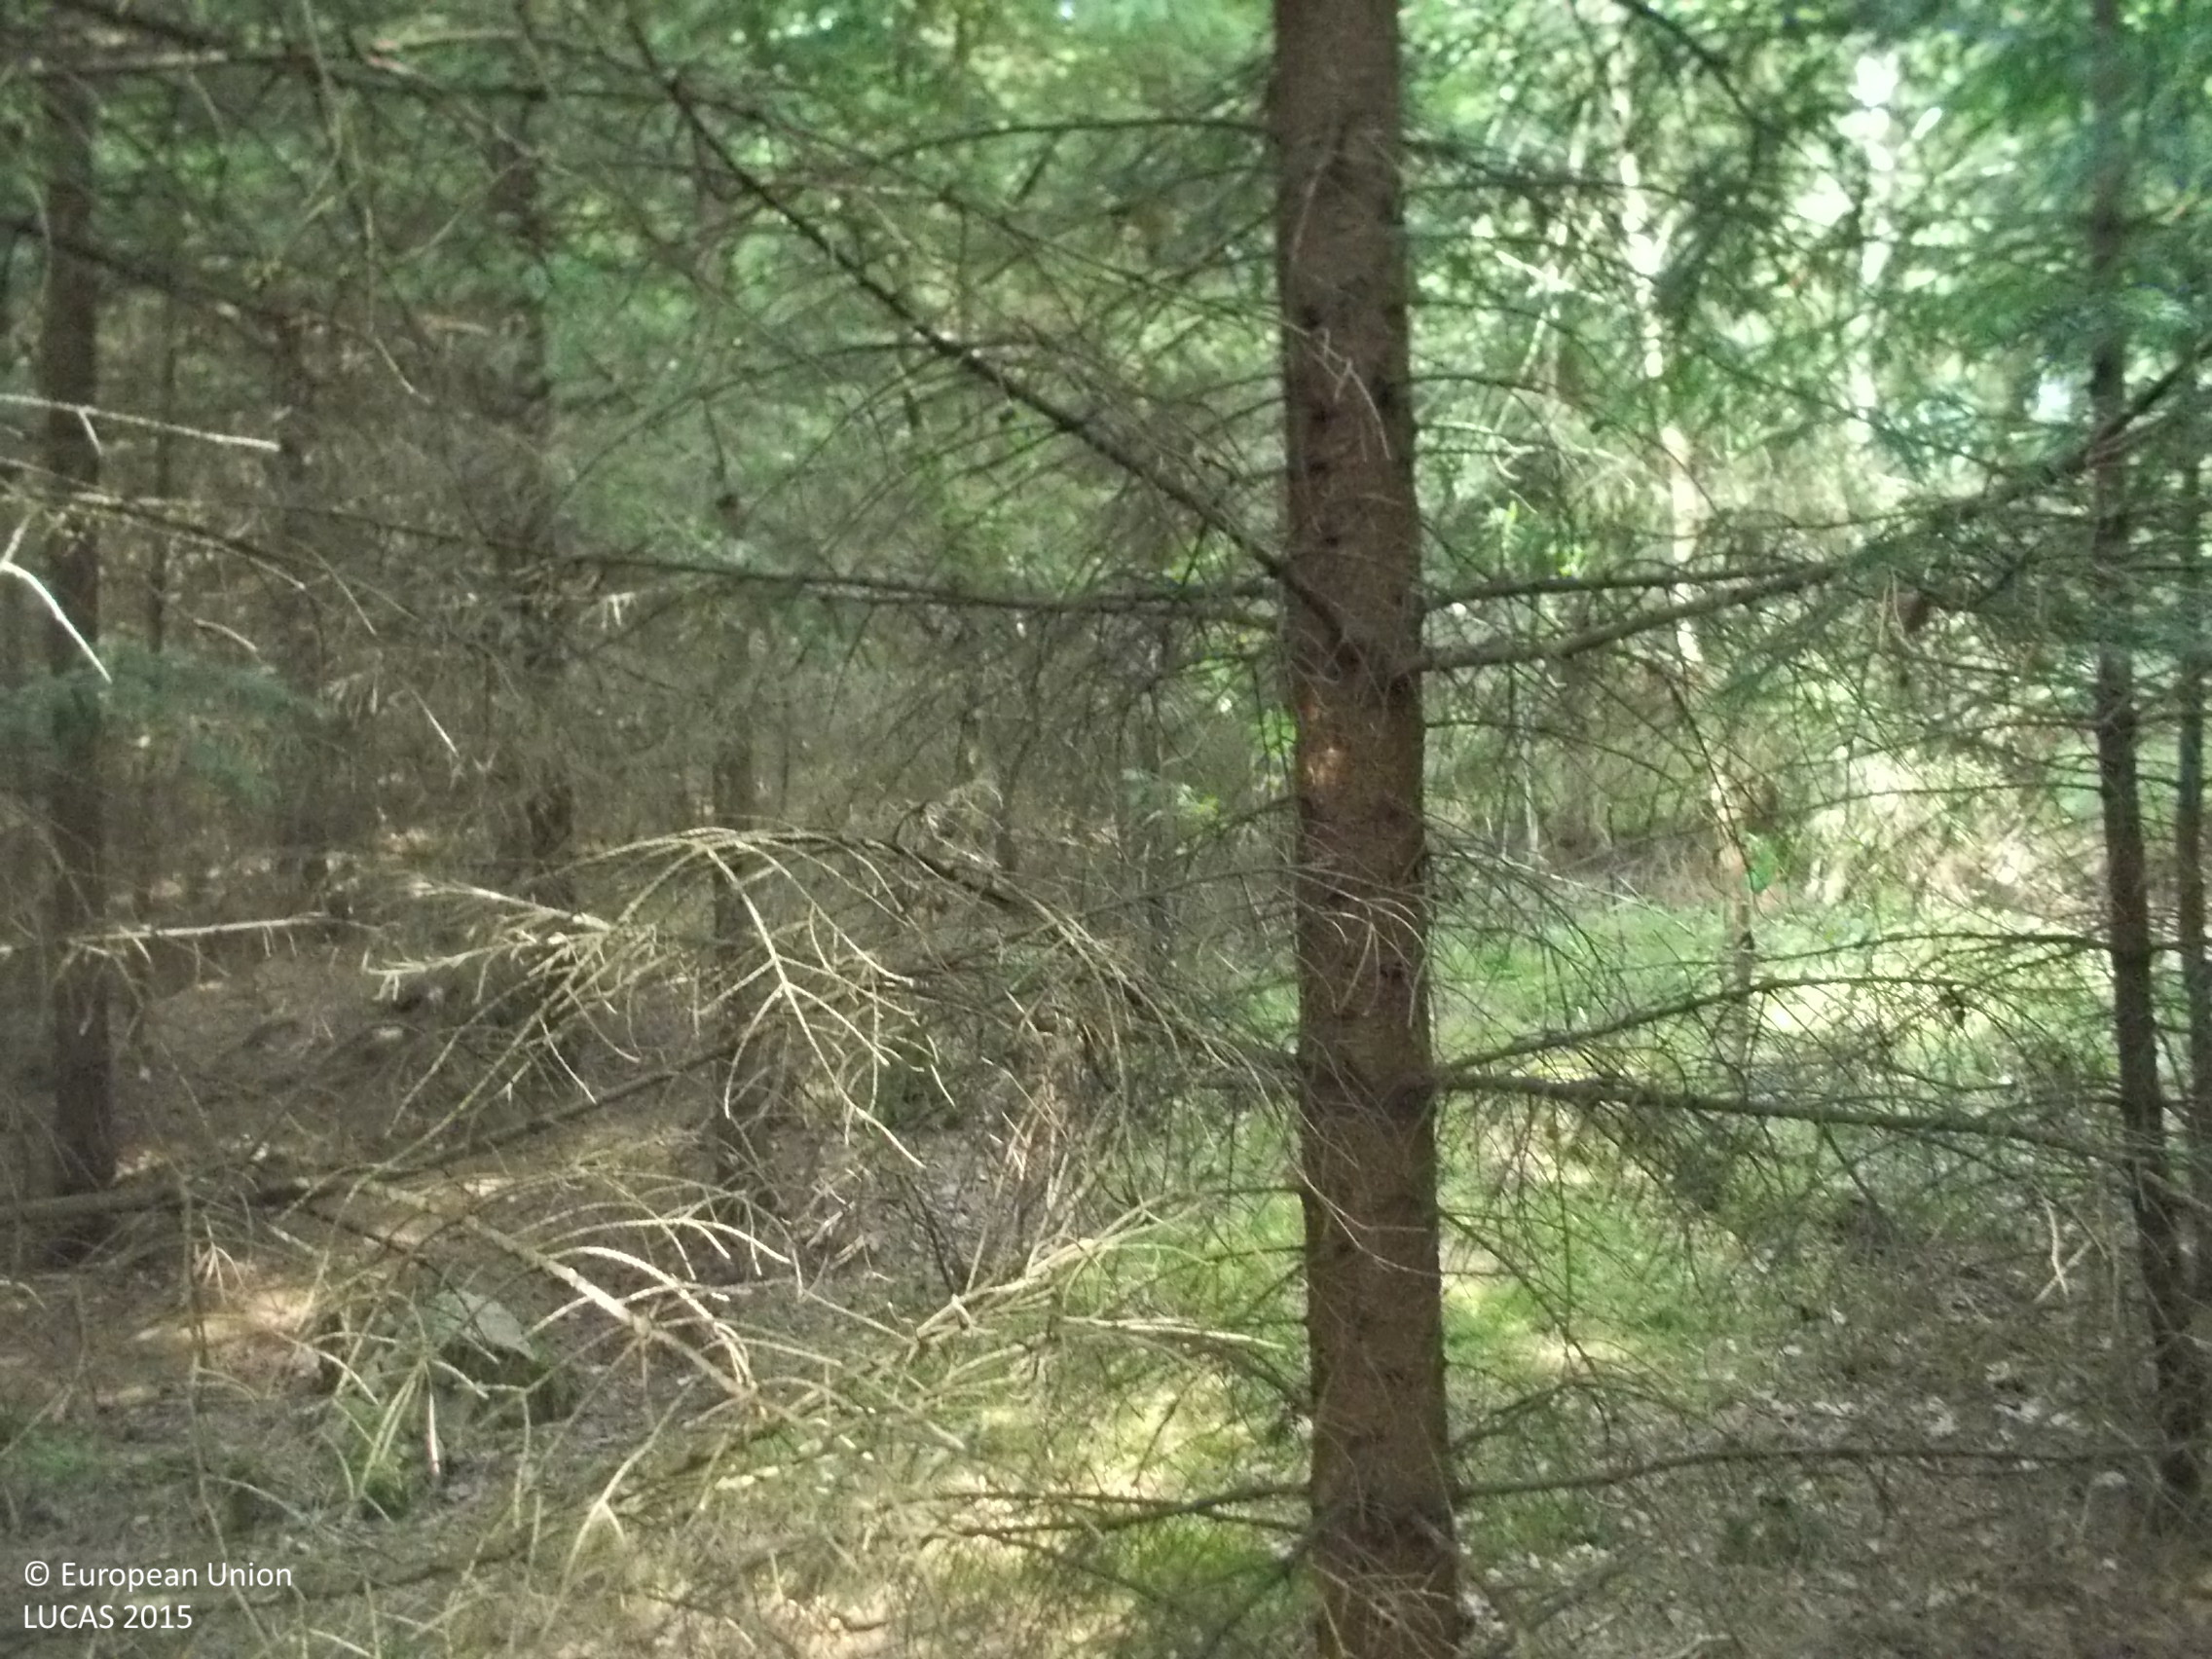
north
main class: Woodland
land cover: Spruce dominated coniferous woodland
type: boreal forest
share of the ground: > 75 %
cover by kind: coniferous forest trees 95 %, lichens and mosses 5 %
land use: Forestry
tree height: > 5 m
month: August
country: SE
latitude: 57.4823
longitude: 13.0814
